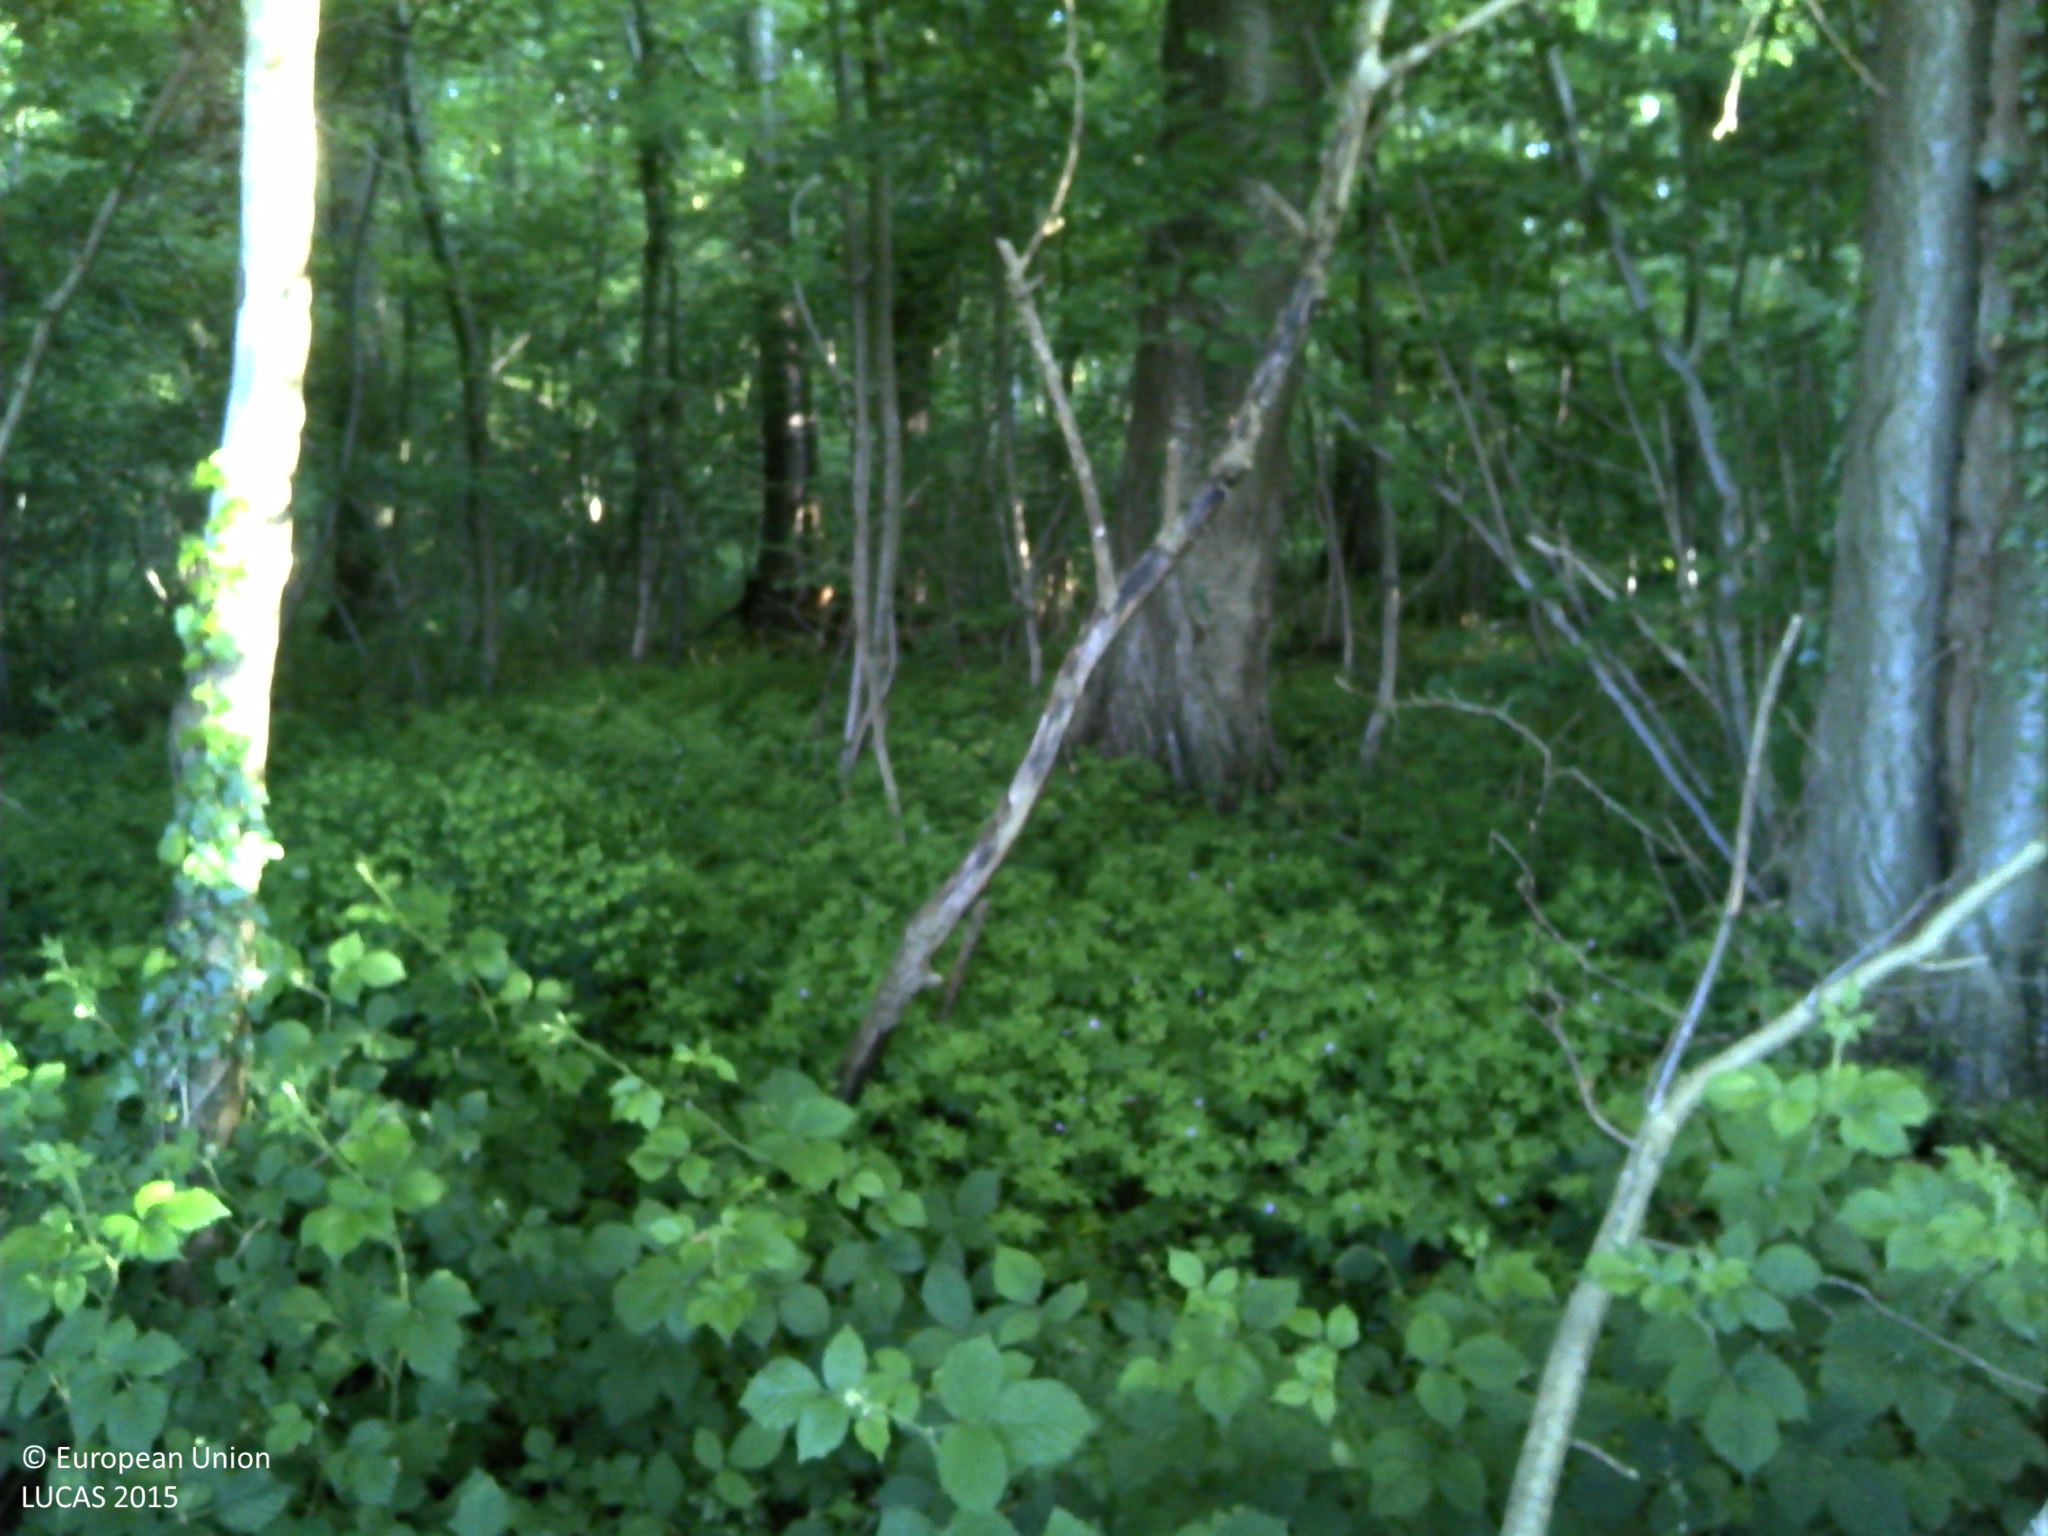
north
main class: Woodland
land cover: Broadleaved woodland
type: mesophytic deciduous forest
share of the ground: > 75 %
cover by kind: broadleaved forest trees 100 %
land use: Forestry
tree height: > 5 m
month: June
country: FR
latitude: 49.7103
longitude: 1.1169
